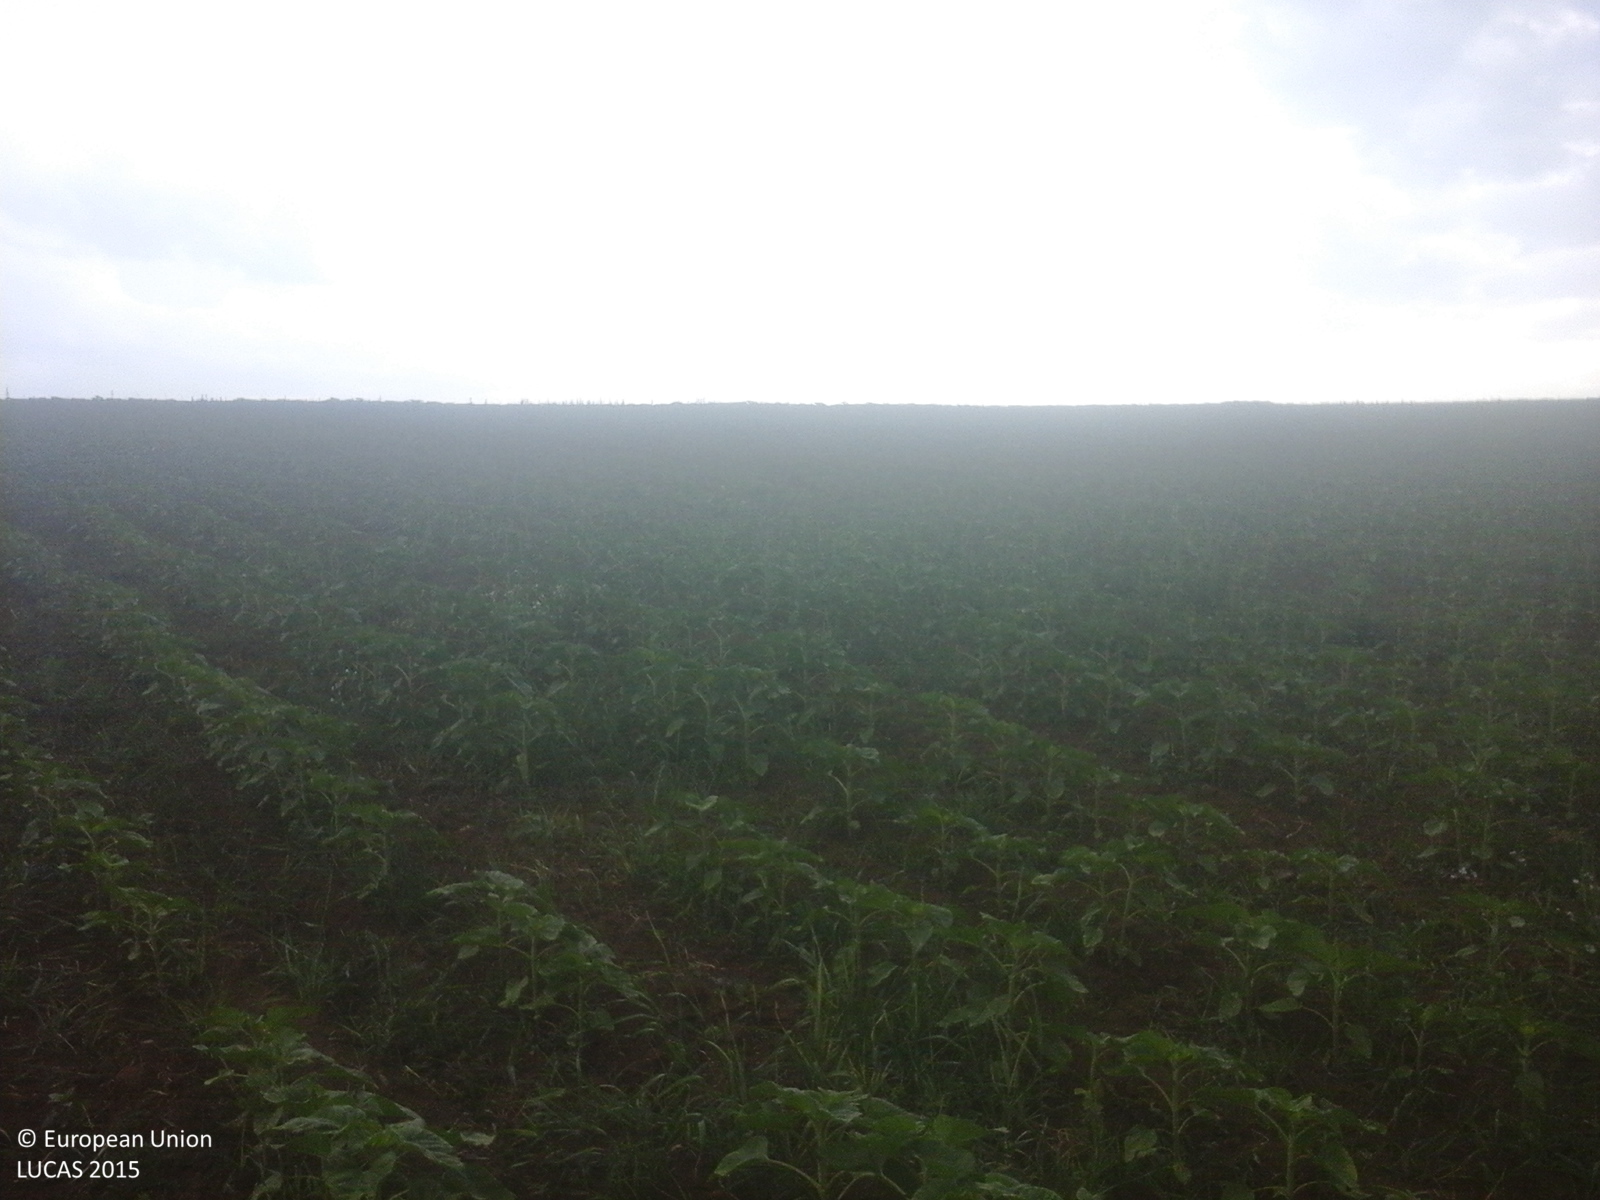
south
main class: Cropland
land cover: Sunflower
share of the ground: 25 - 50 %
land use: Agriculture (excluding fallow land and kitchen gardens)
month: June
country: RO
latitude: 47.0019
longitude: 26.4041
